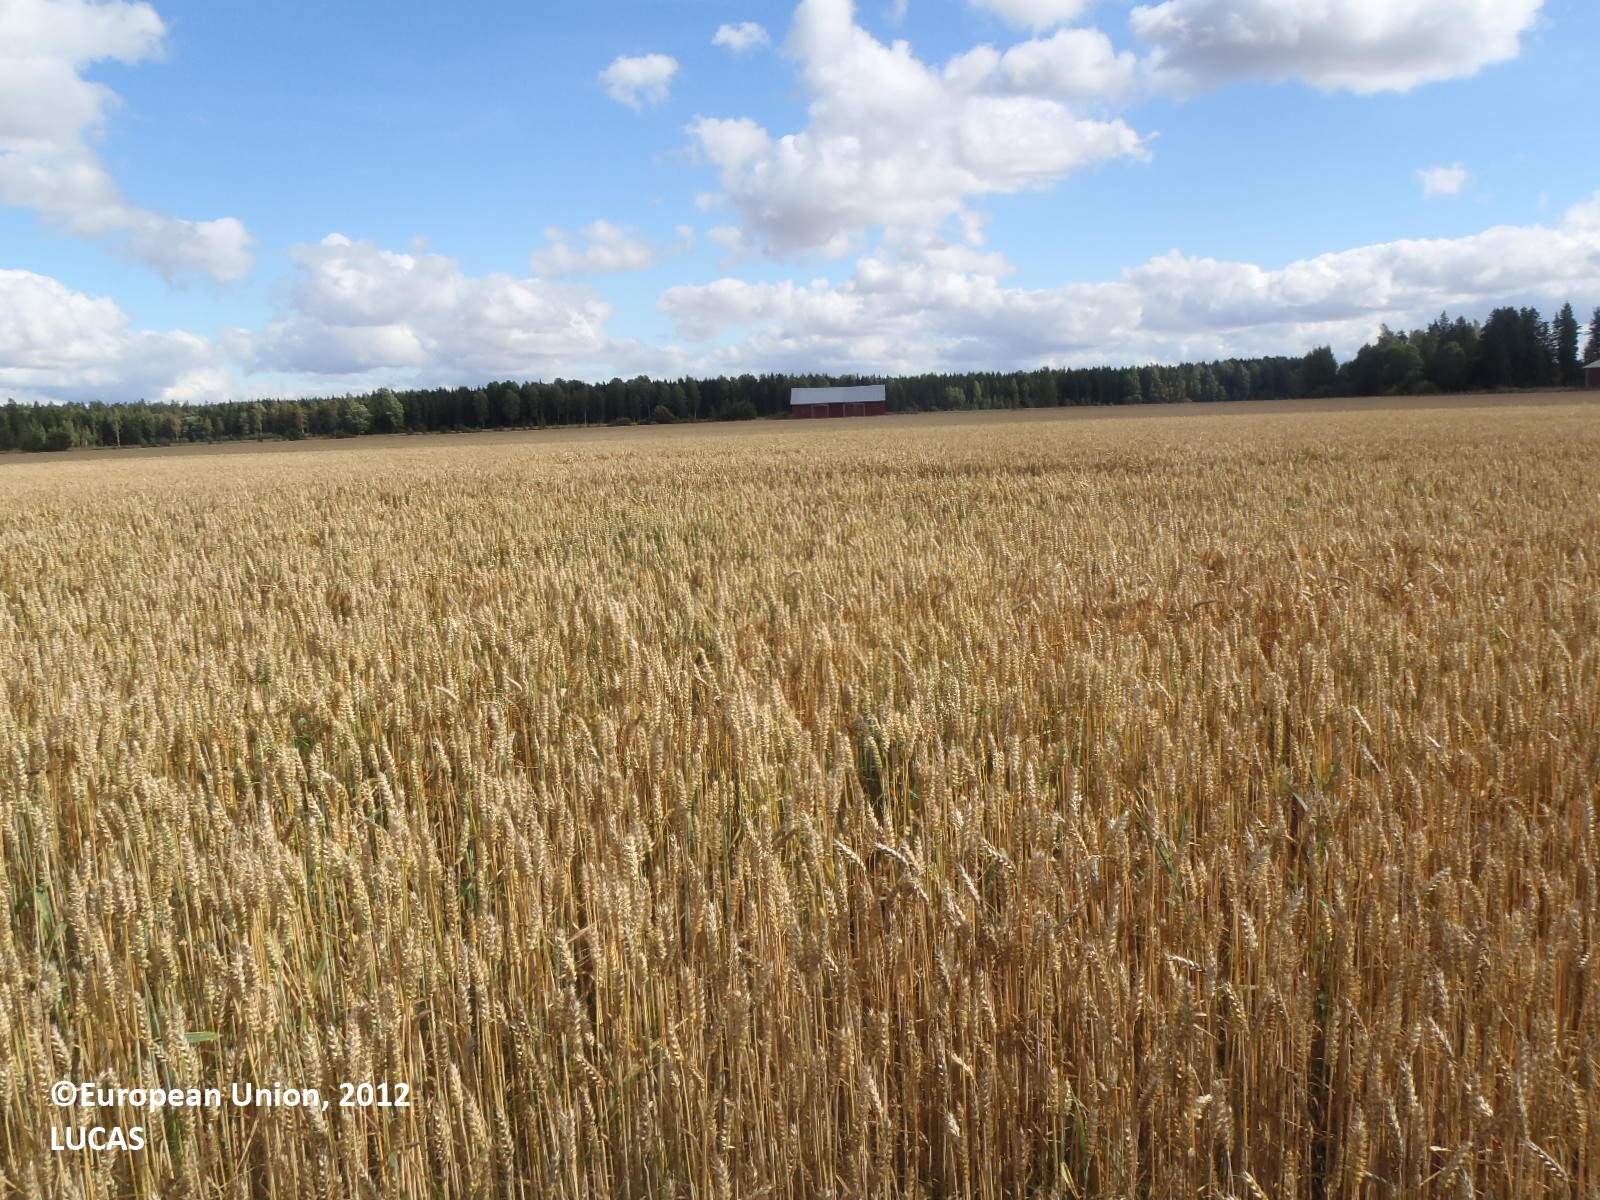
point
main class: Cropland
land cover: Common wheat
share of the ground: > 75 %
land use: Agriculture (excluding fallow land and kitchen gardens)
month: September
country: FI
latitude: 60.9078
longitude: 22.6253
